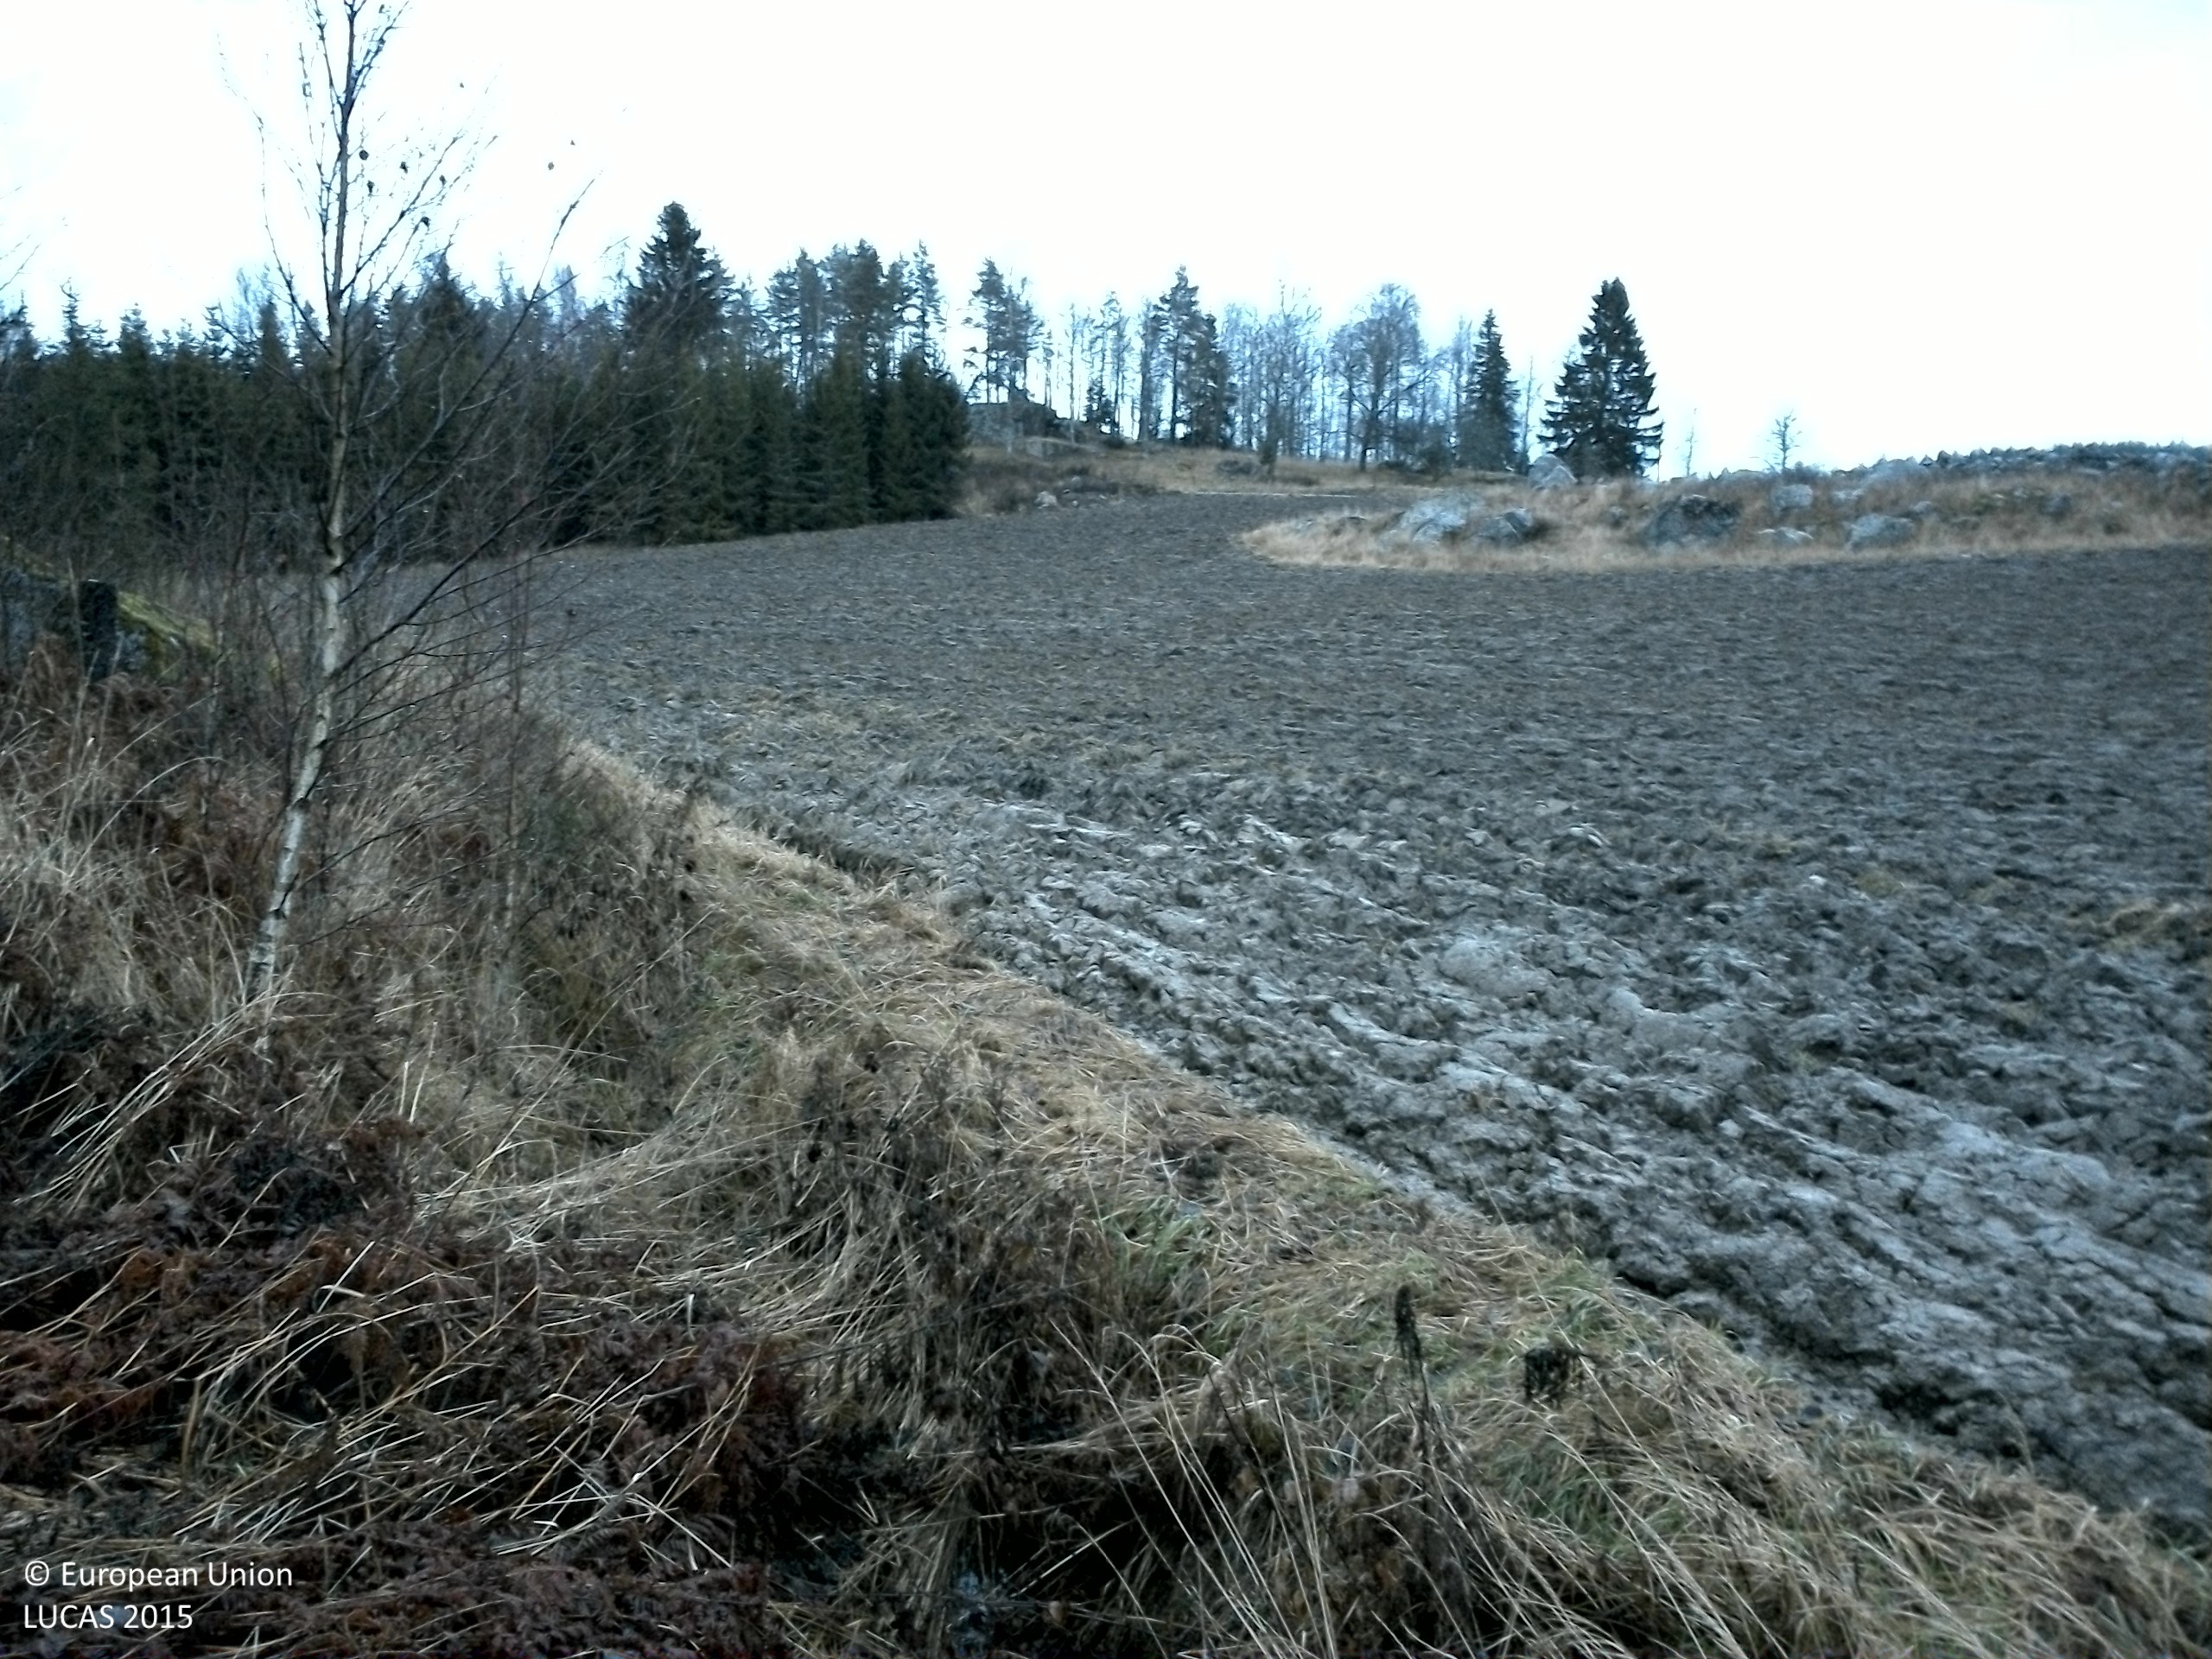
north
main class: Woodland
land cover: Broadleaved woodland
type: hemiboreal forest and nemoral coniferous forest and mixed broadleaved-coniferous forest
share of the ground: 25 - 50 %
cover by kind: herbaceous plants 55 %, broadleaved forest trees 35 %, consolidated bare surface 10 %
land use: Forestry
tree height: > 5 m
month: November
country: SE
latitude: 59.1366
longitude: 16.6879
